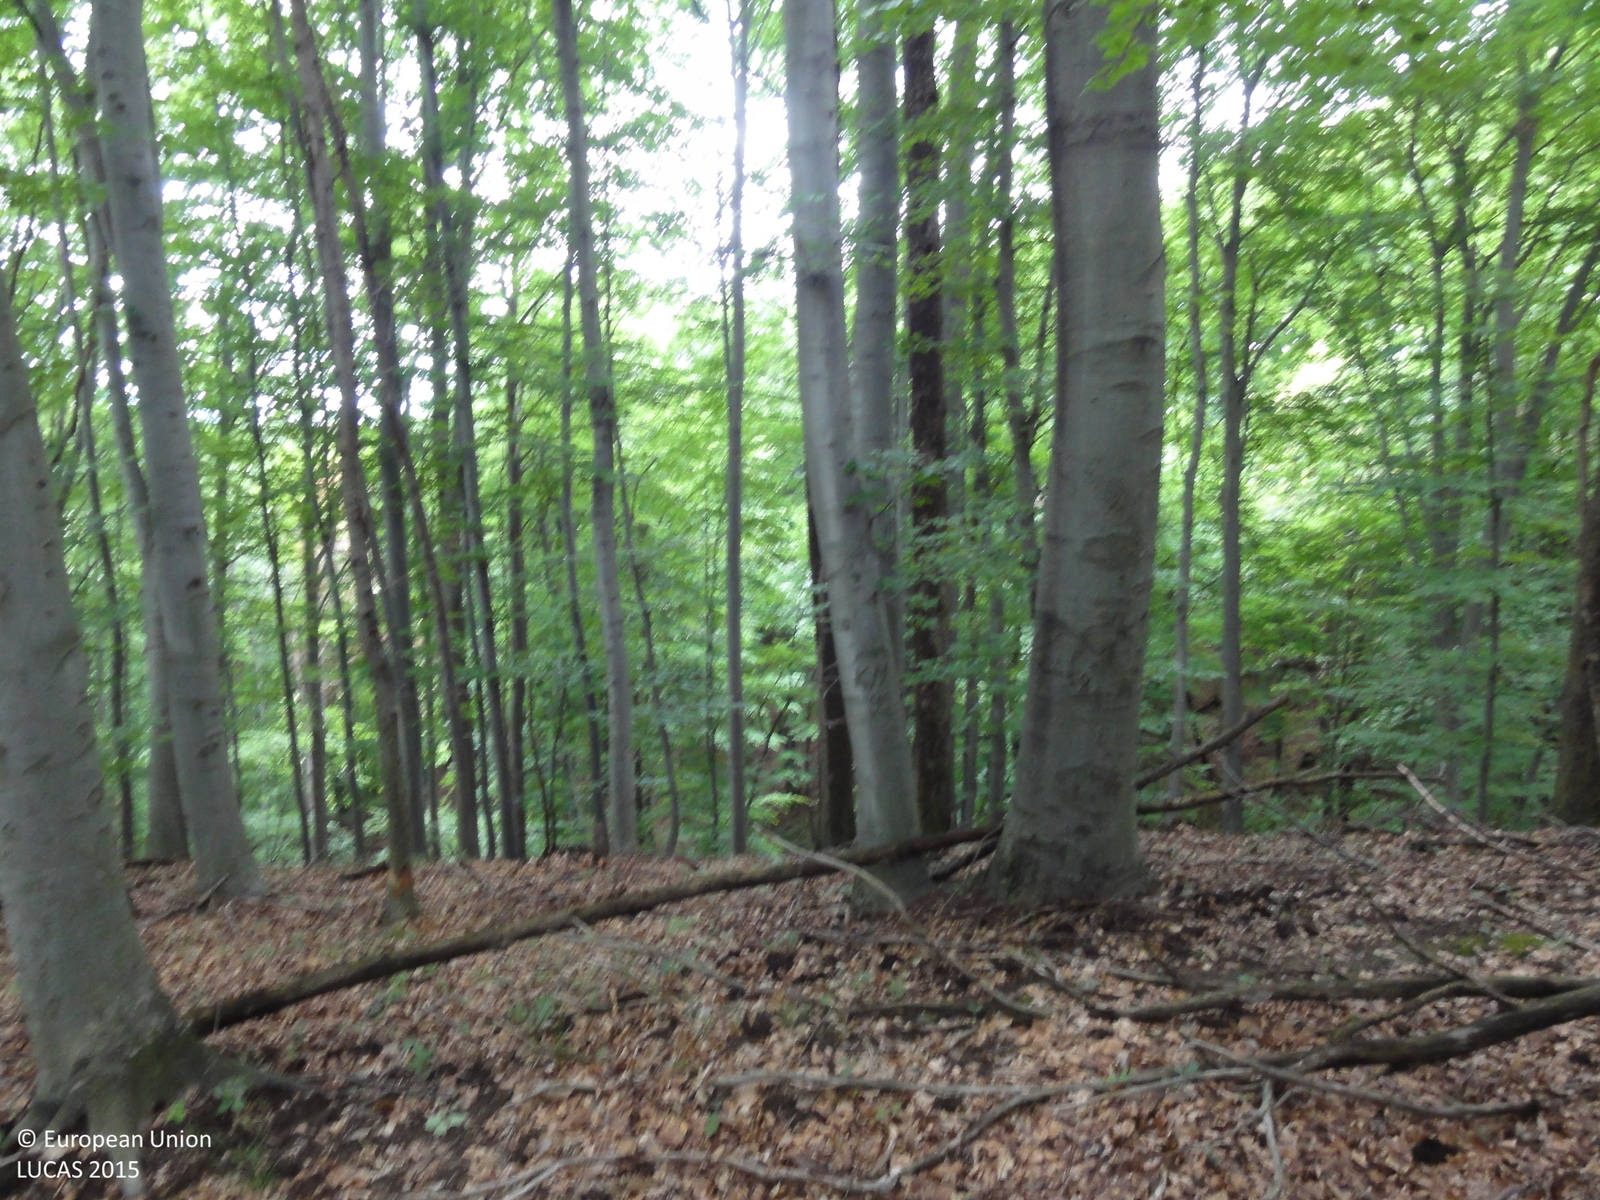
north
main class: Woodland
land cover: Broadleaved woodland
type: beech forest
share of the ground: > 75 %
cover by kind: broadleaved forest trees 100 %
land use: Forestry
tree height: > 5 m
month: June
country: SI
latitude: 46.3256
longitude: 15.7007
